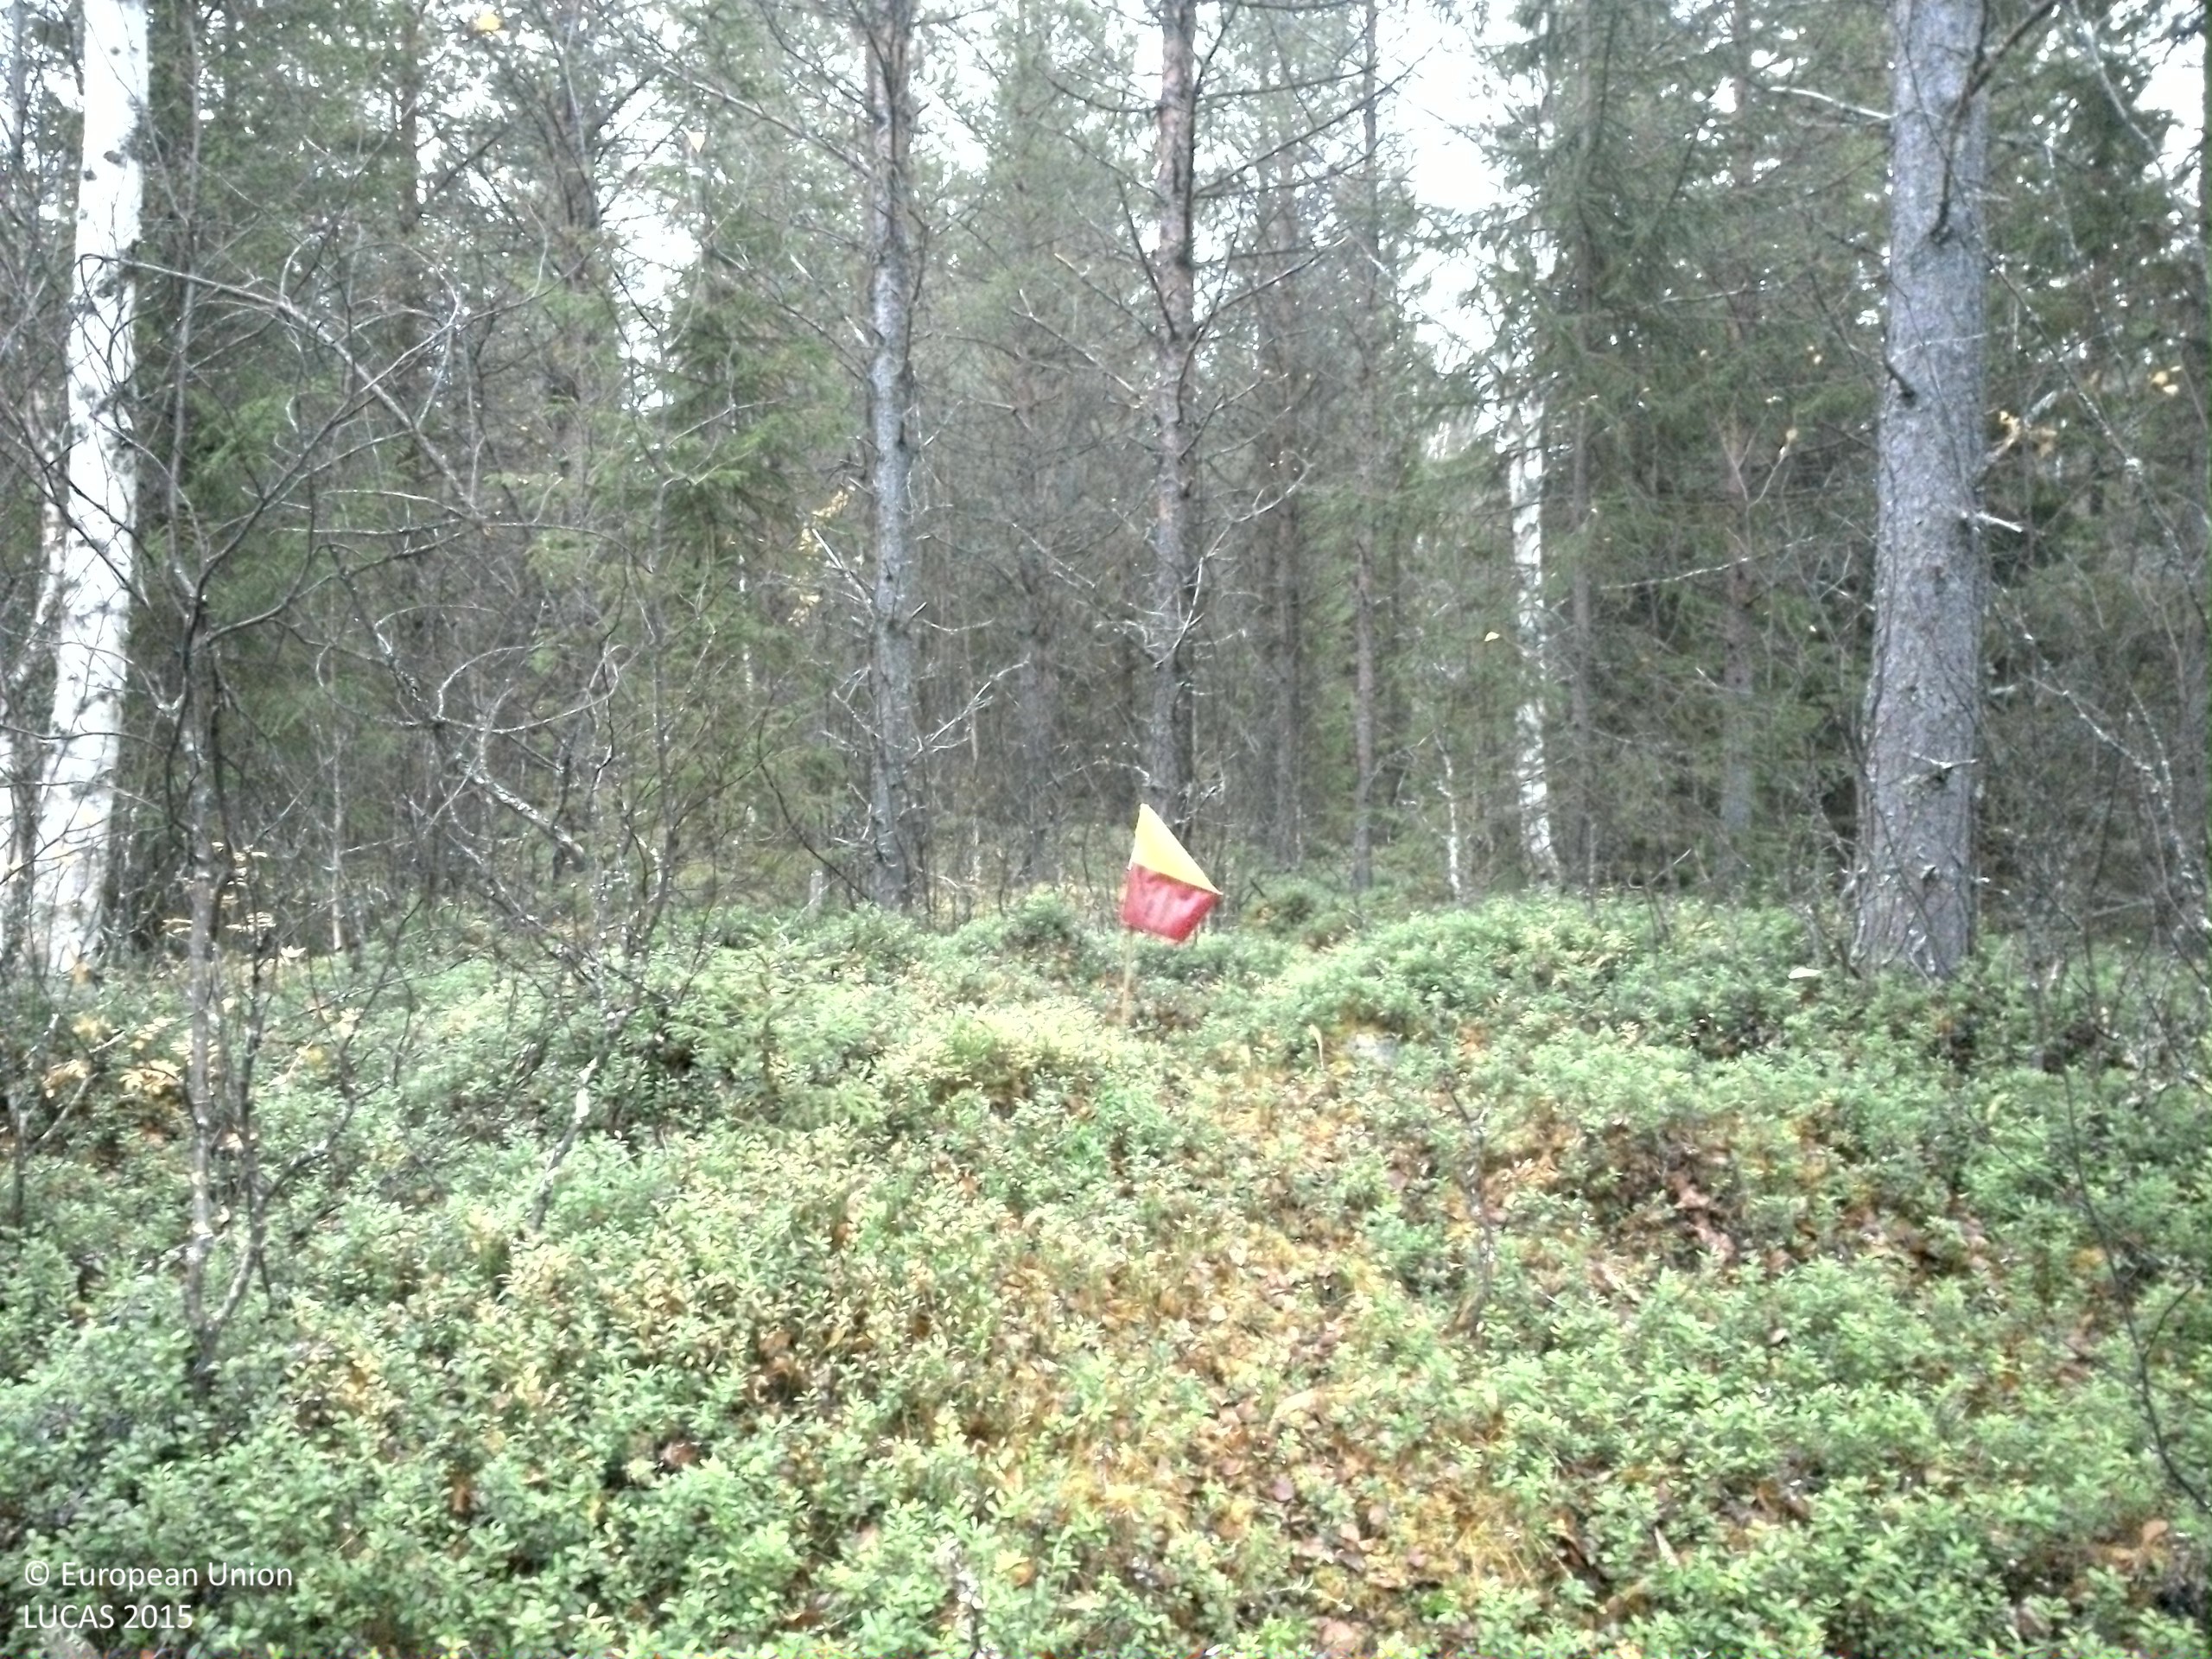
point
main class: Woodland
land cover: Other mixed woodland
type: boreal forest
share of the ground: 50 - 75 %
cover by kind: coniferous forest trees 45 %, shrubs 30 %, broadleaved forest trees 15 %, lichens and mosses 10 %
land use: Forestry
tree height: > 5 m
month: October
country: SE
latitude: 64.3101
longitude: 15.2852
